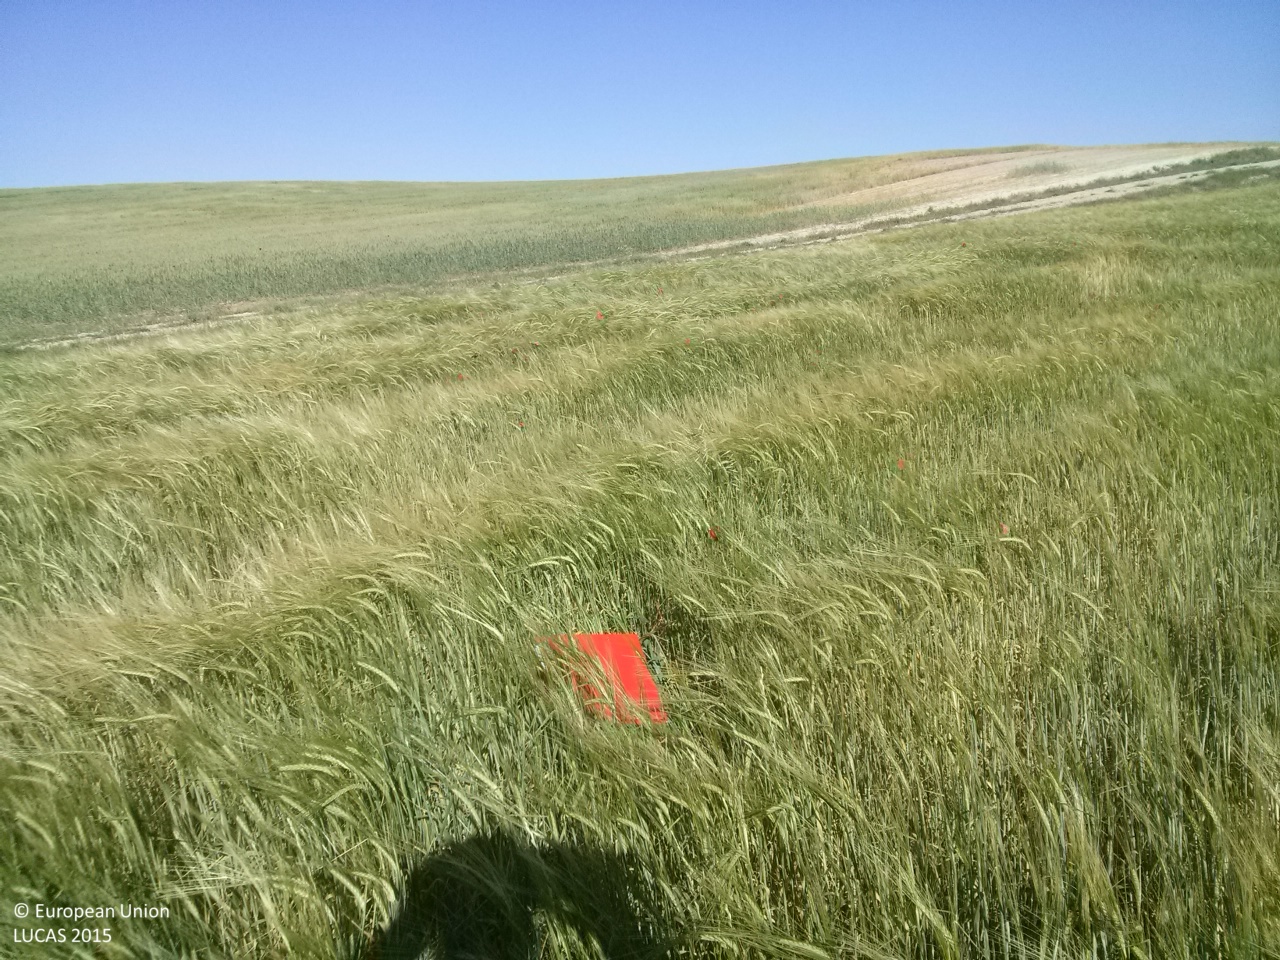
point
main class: Cropland
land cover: Barley
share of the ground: > 75 %
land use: Agriculture (excluding fallow land and kitchen gardens)
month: May
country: ES
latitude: 40.1679
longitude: -2.7158
